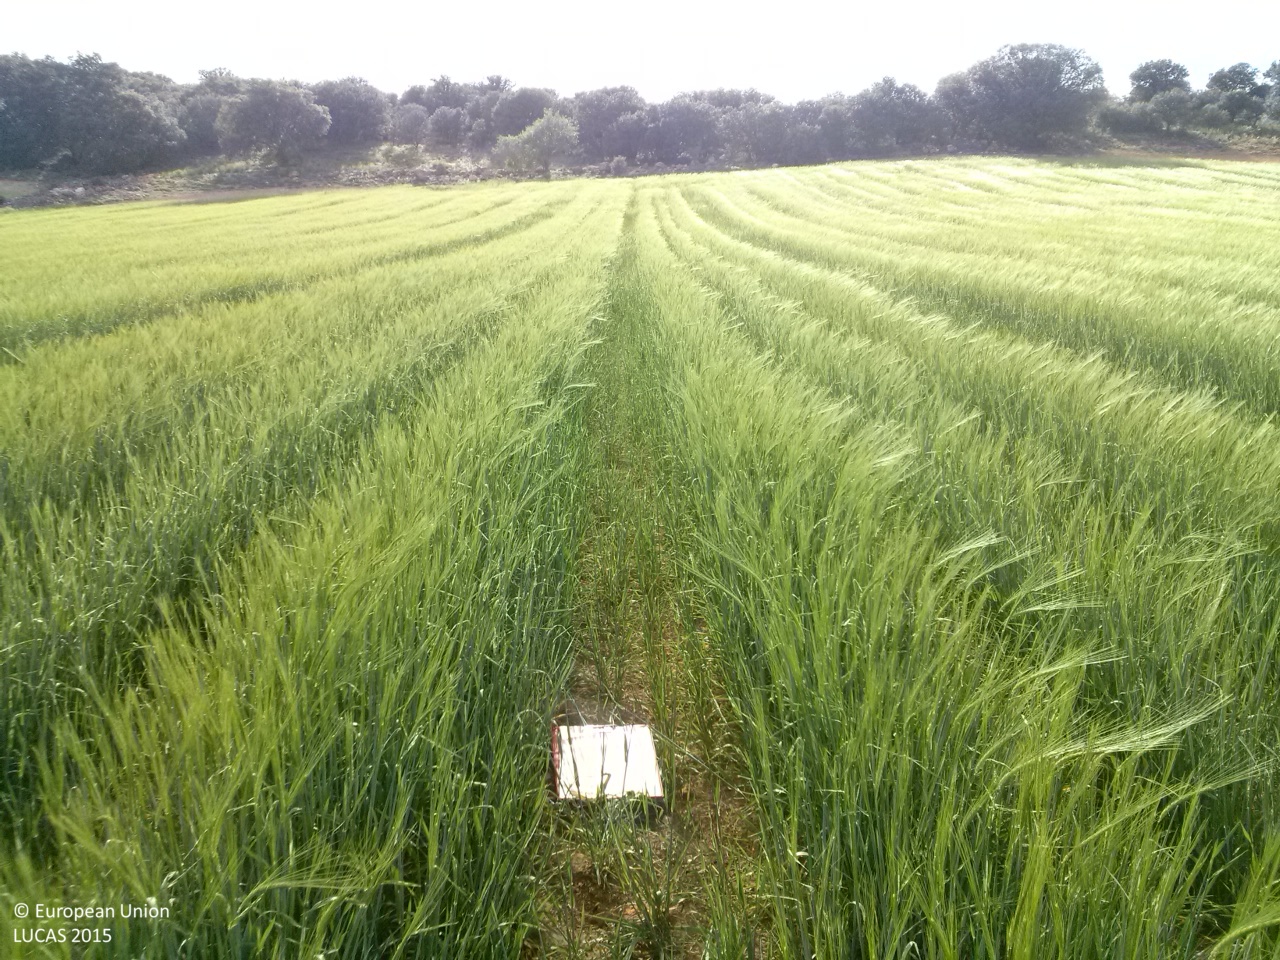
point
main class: Cropland
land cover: Barley
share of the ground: > 75 %
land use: Agriculture (excluding fallow land and kitchen gardens)
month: May
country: ES
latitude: 39.8407
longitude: -2.8396
